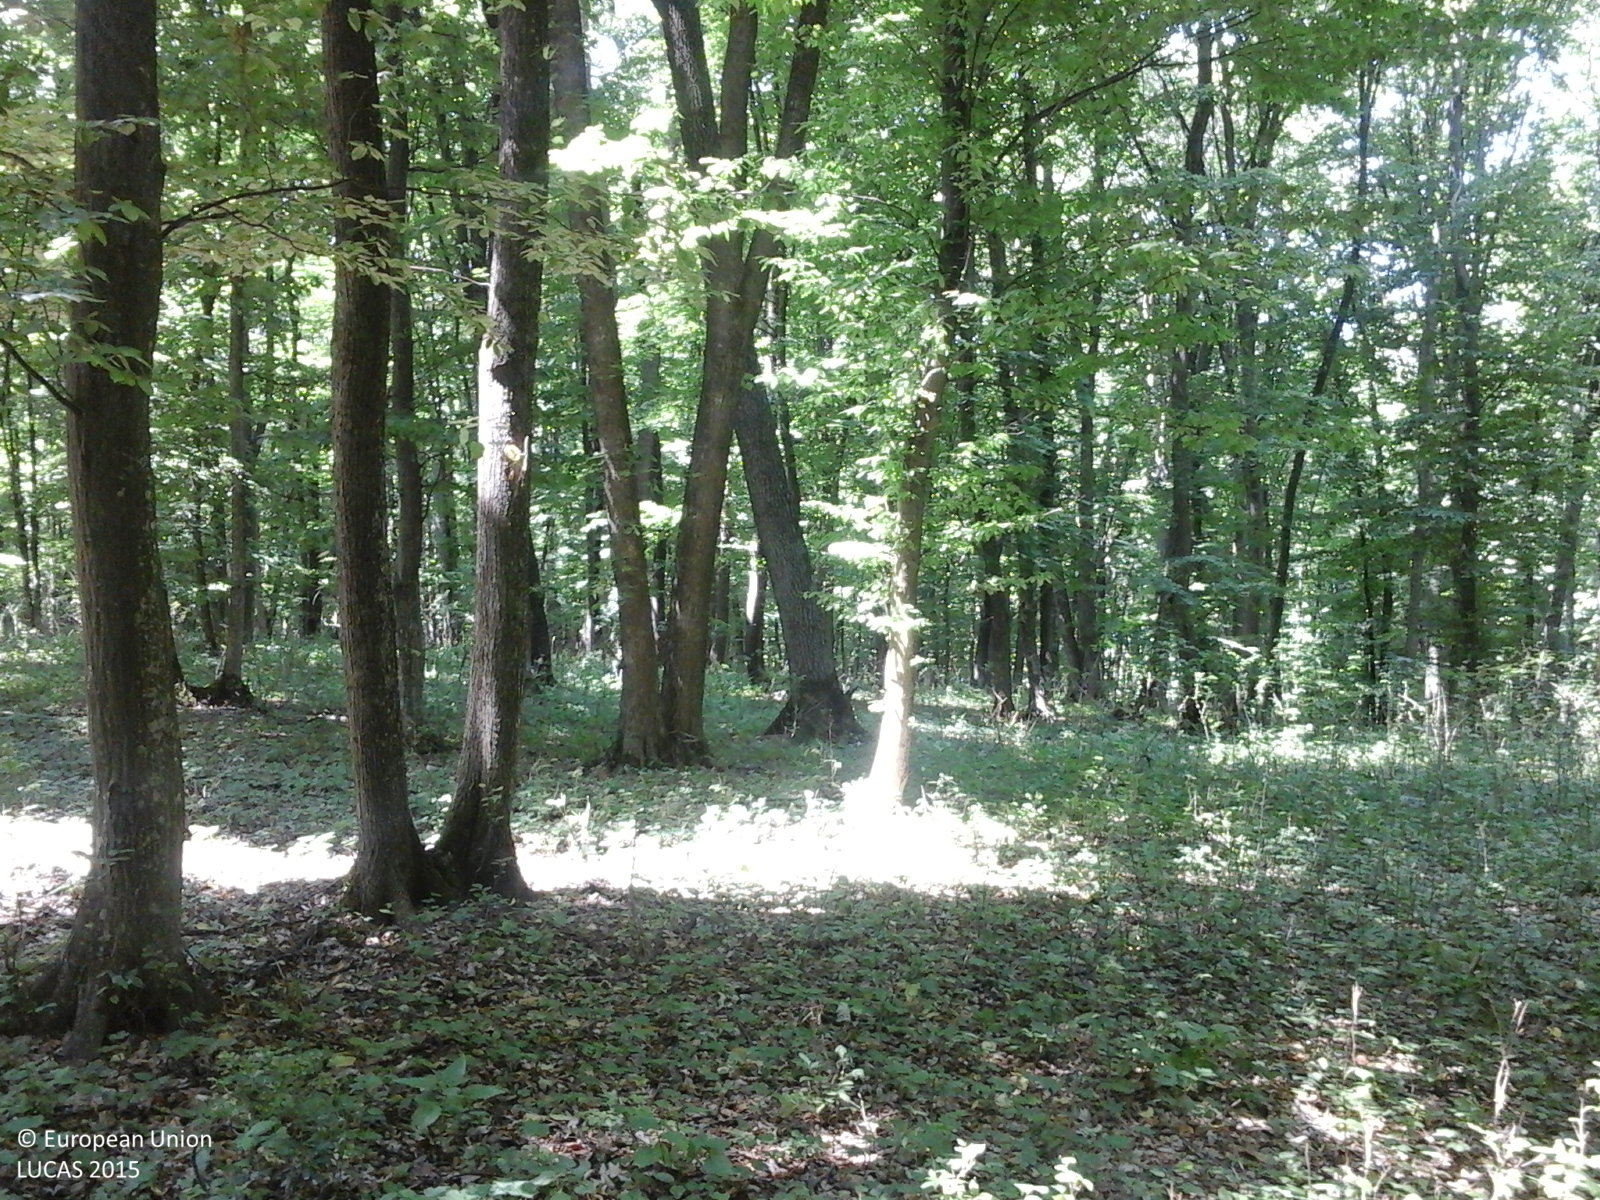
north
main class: Woodland
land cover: Broadleaved woodland
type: acidophilous oak and oak-birch forest
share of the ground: > 75 %
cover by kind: broadleaved forest trees 100 %
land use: Forestry
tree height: > 5 m
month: June
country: RO
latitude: 47.3558
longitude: 26.8451
